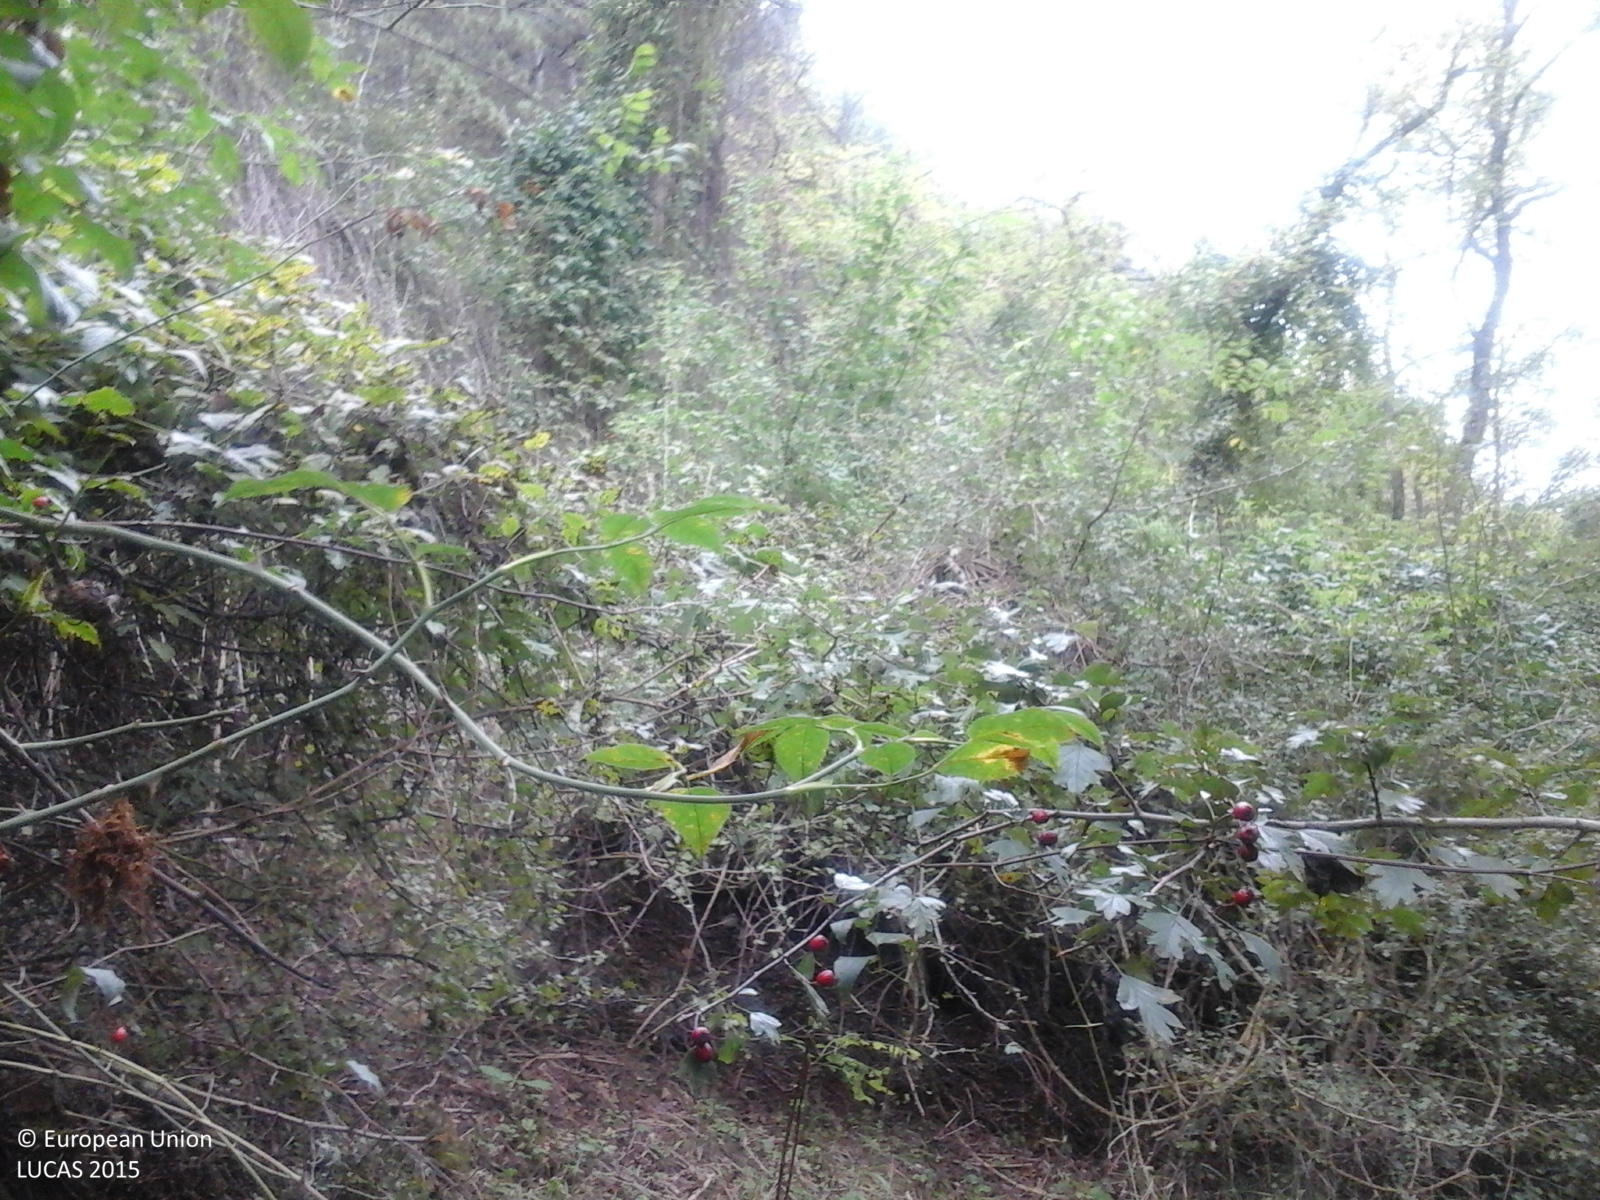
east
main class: Woodland
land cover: Broadleaved woodland
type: exotic forest
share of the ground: > 75 %
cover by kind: broadleaved forest trees 100 %
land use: Forestry
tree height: > 5 m
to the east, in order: Broadleaved woodland; Tracks; Spruce dominated coniferous woodland; Grassland with sparse tree/shrub cover; Other mixed woodland
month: October
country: RO
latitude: 46.0460
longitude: 23.4392
